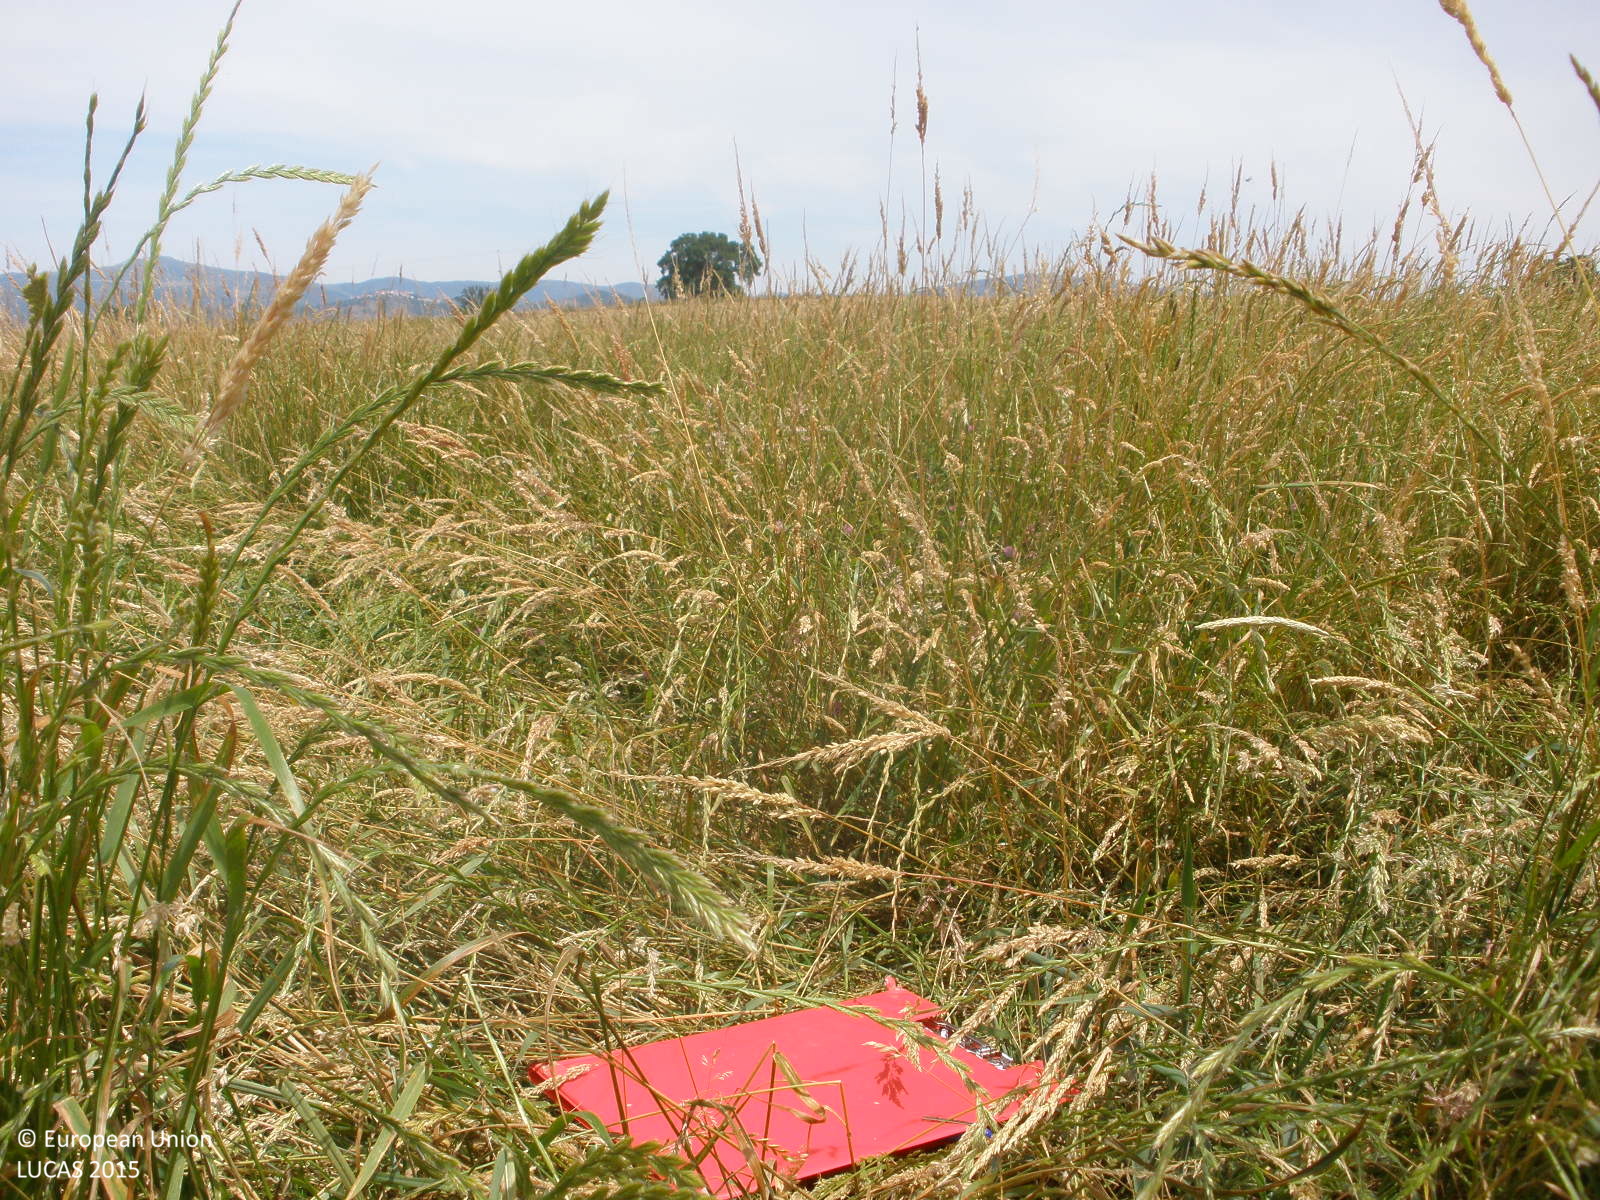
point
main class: Cropland
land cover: Mixed cereals for fodder
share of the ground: > 75 %
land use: Agriculture (excluding fallow land and kitchen gardens)
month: May
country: ES
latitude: 40.1049
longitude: -6.5410
